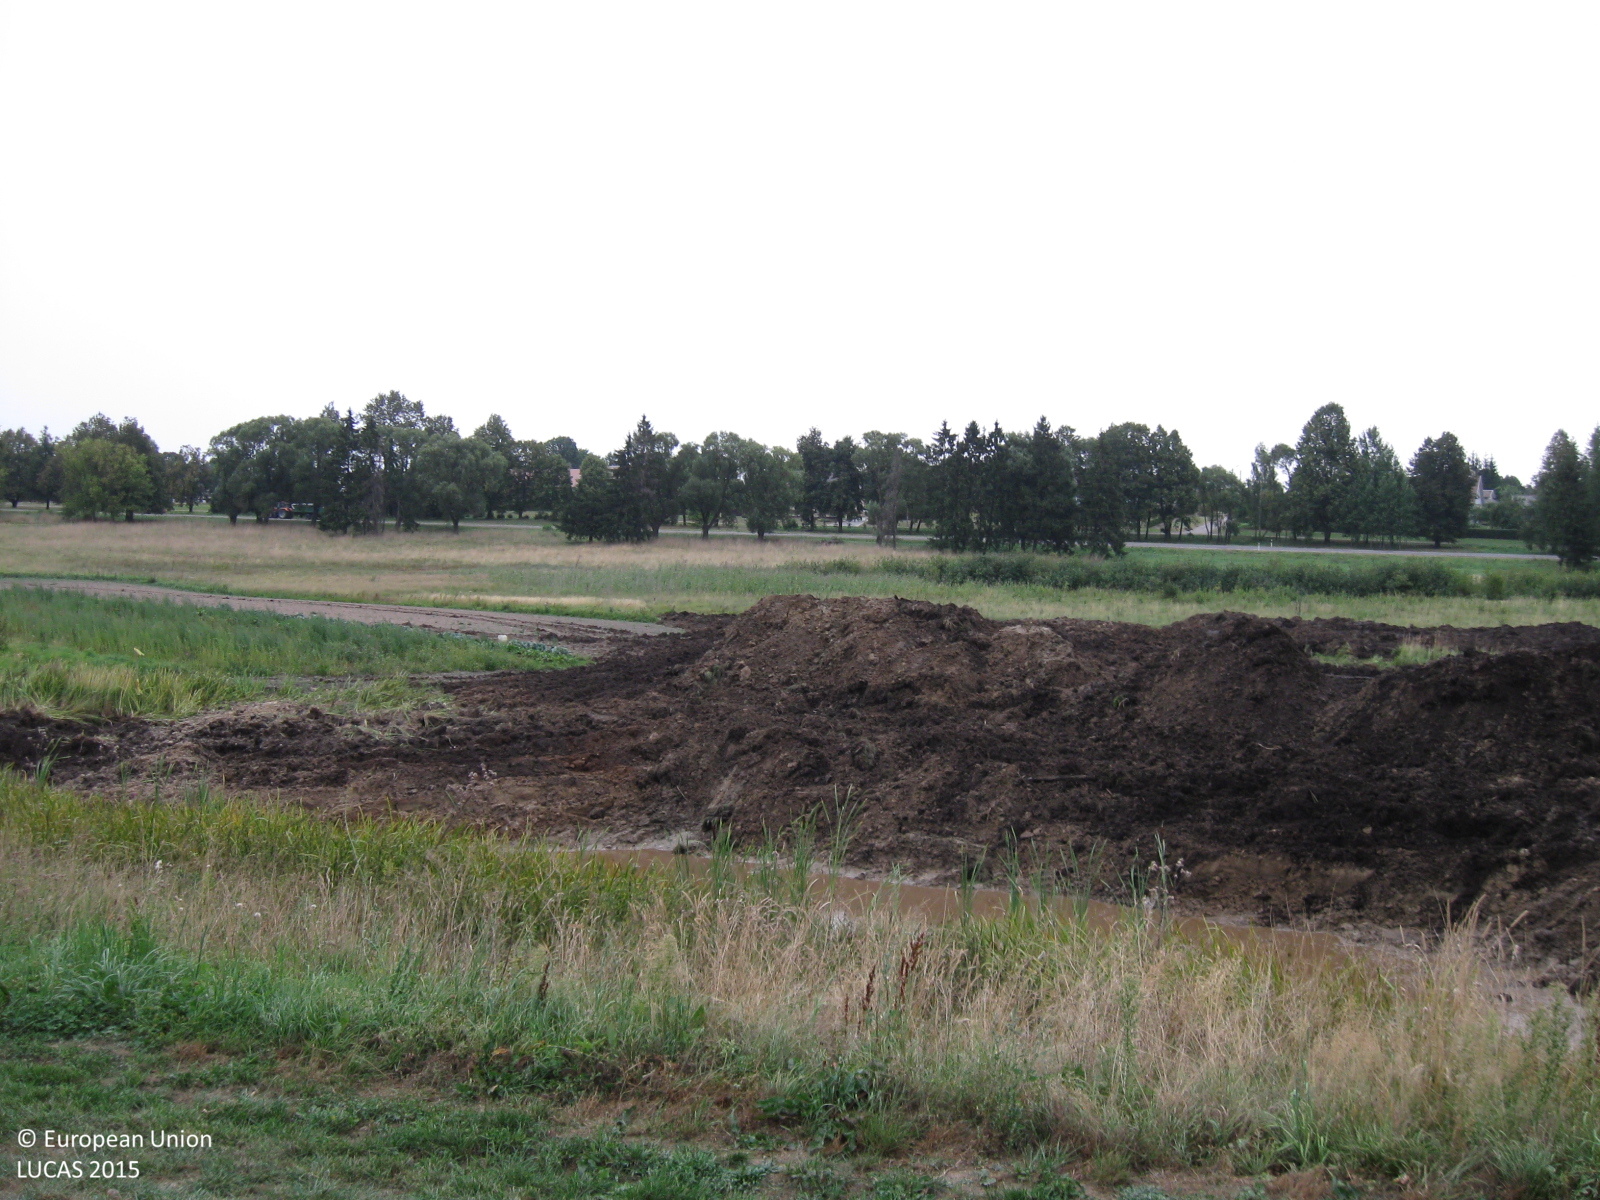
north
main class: Grassland
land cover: Grassland without tree/shrub cover
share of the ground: > 75 %
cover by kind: herbaceous plants 100 %
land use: Agriculture (excluding fallow land and kitchen gardens)
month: August
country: LT
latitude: 55.3806
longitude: 22.9641
